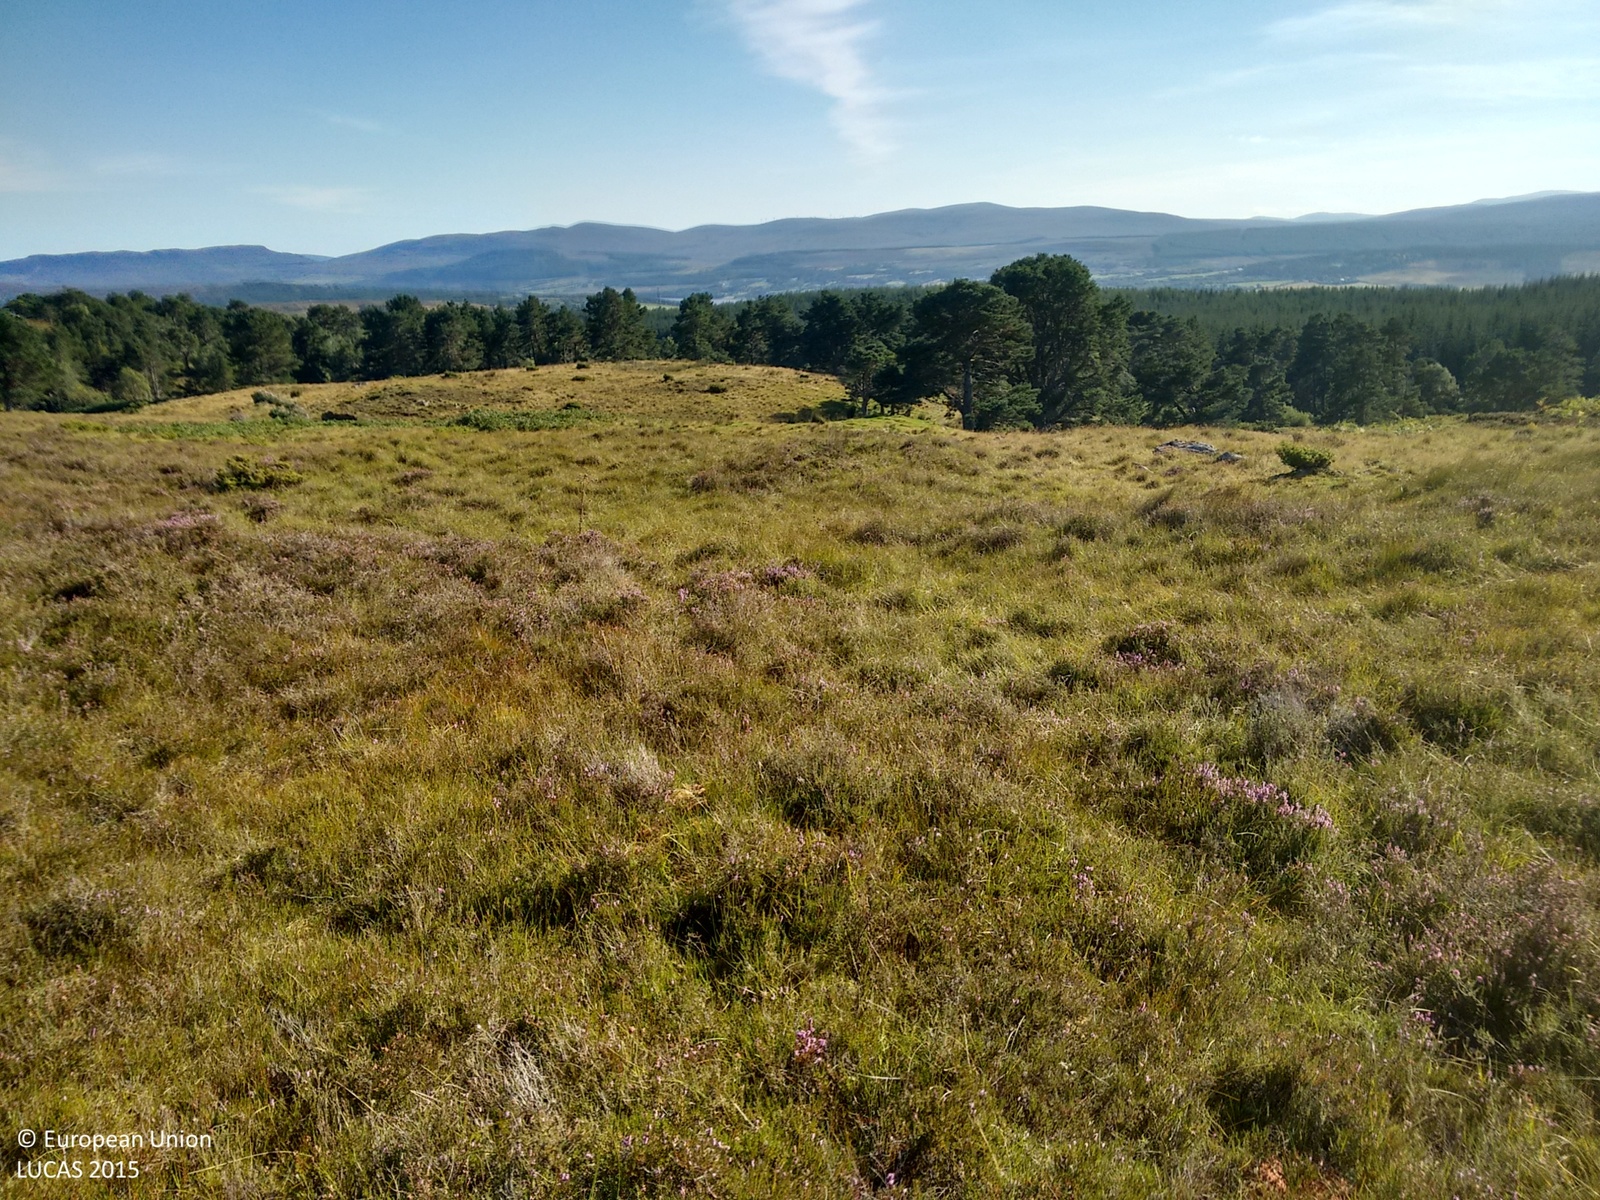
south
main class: Shrubland
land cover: Shrubland without tree cover
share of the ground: > 75 %
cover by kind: shrubs 100 %
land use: Agriculture (excluding fallow land and kitchen gardens)
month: September
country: GB
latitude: 57.9199
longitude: -4.3503
